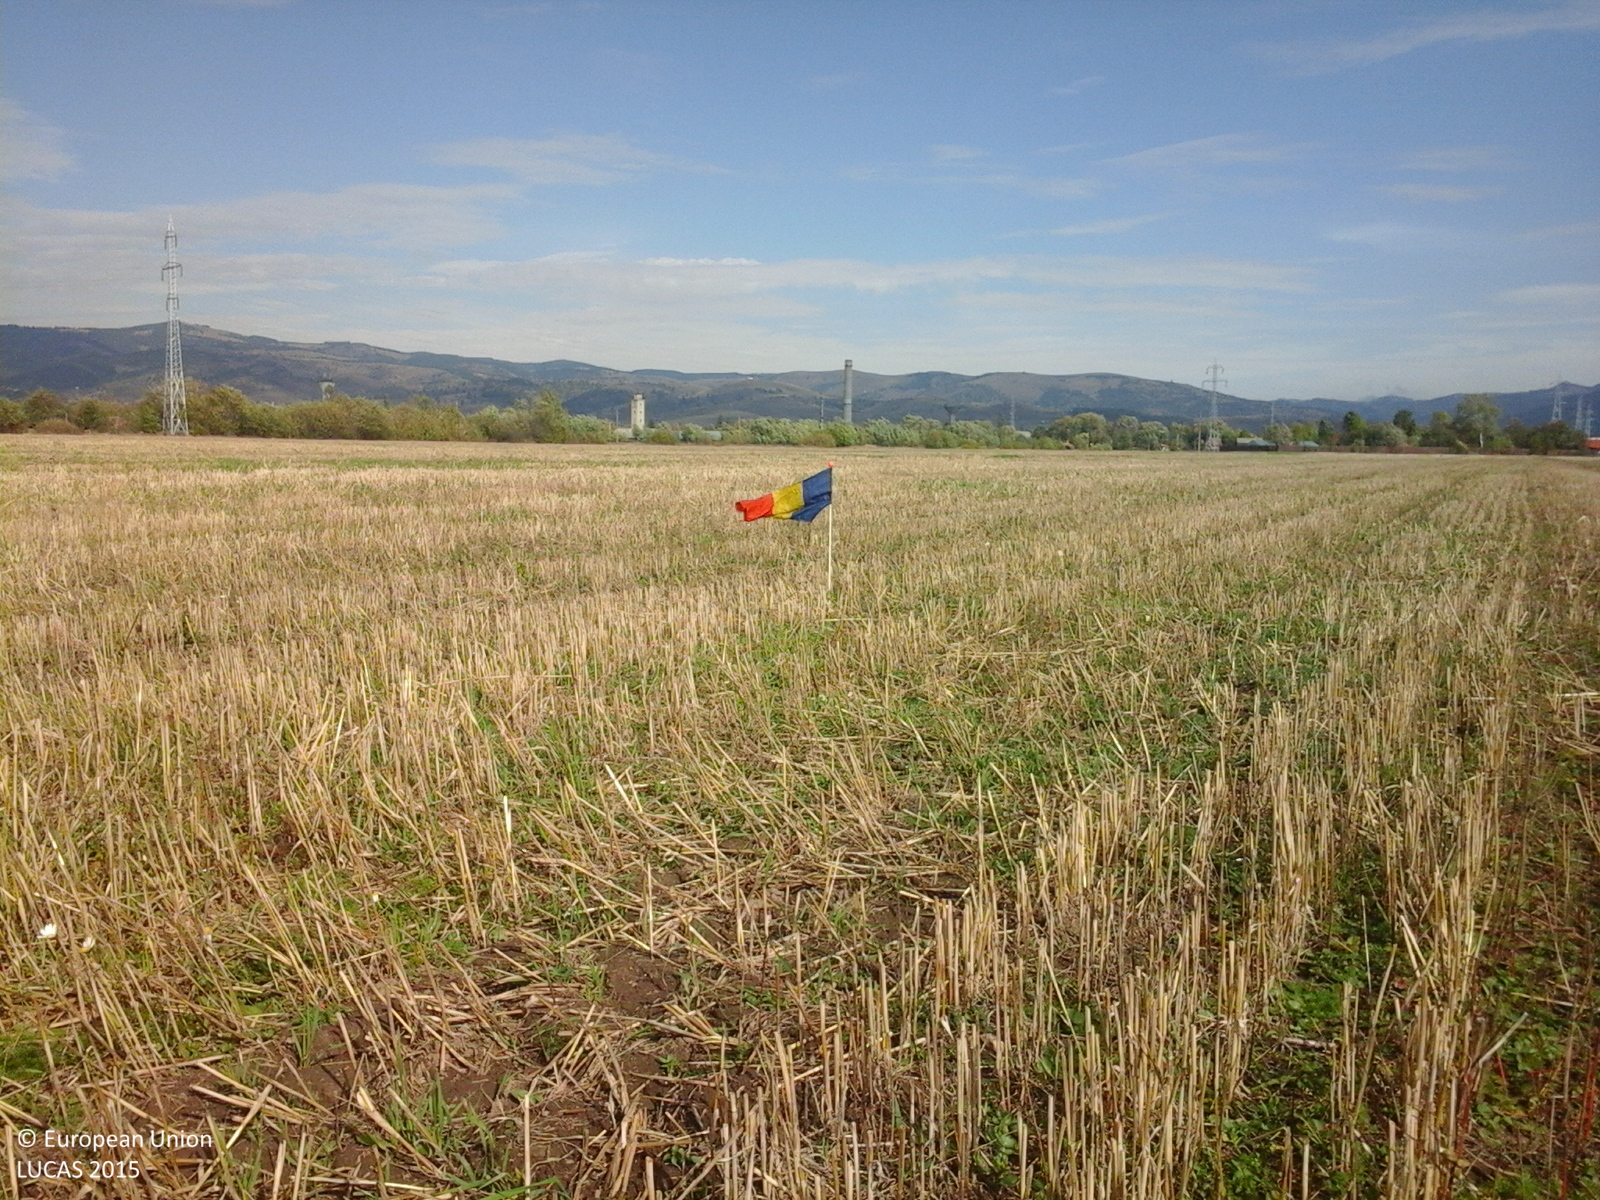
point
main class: Cropland
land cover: Oats
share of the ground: > 75 %
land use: Agriculture (excluding fallow land and kitchen gardens)
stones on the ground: < 10 %
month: October
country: RO
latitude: 46.7068
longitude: 25.5591
